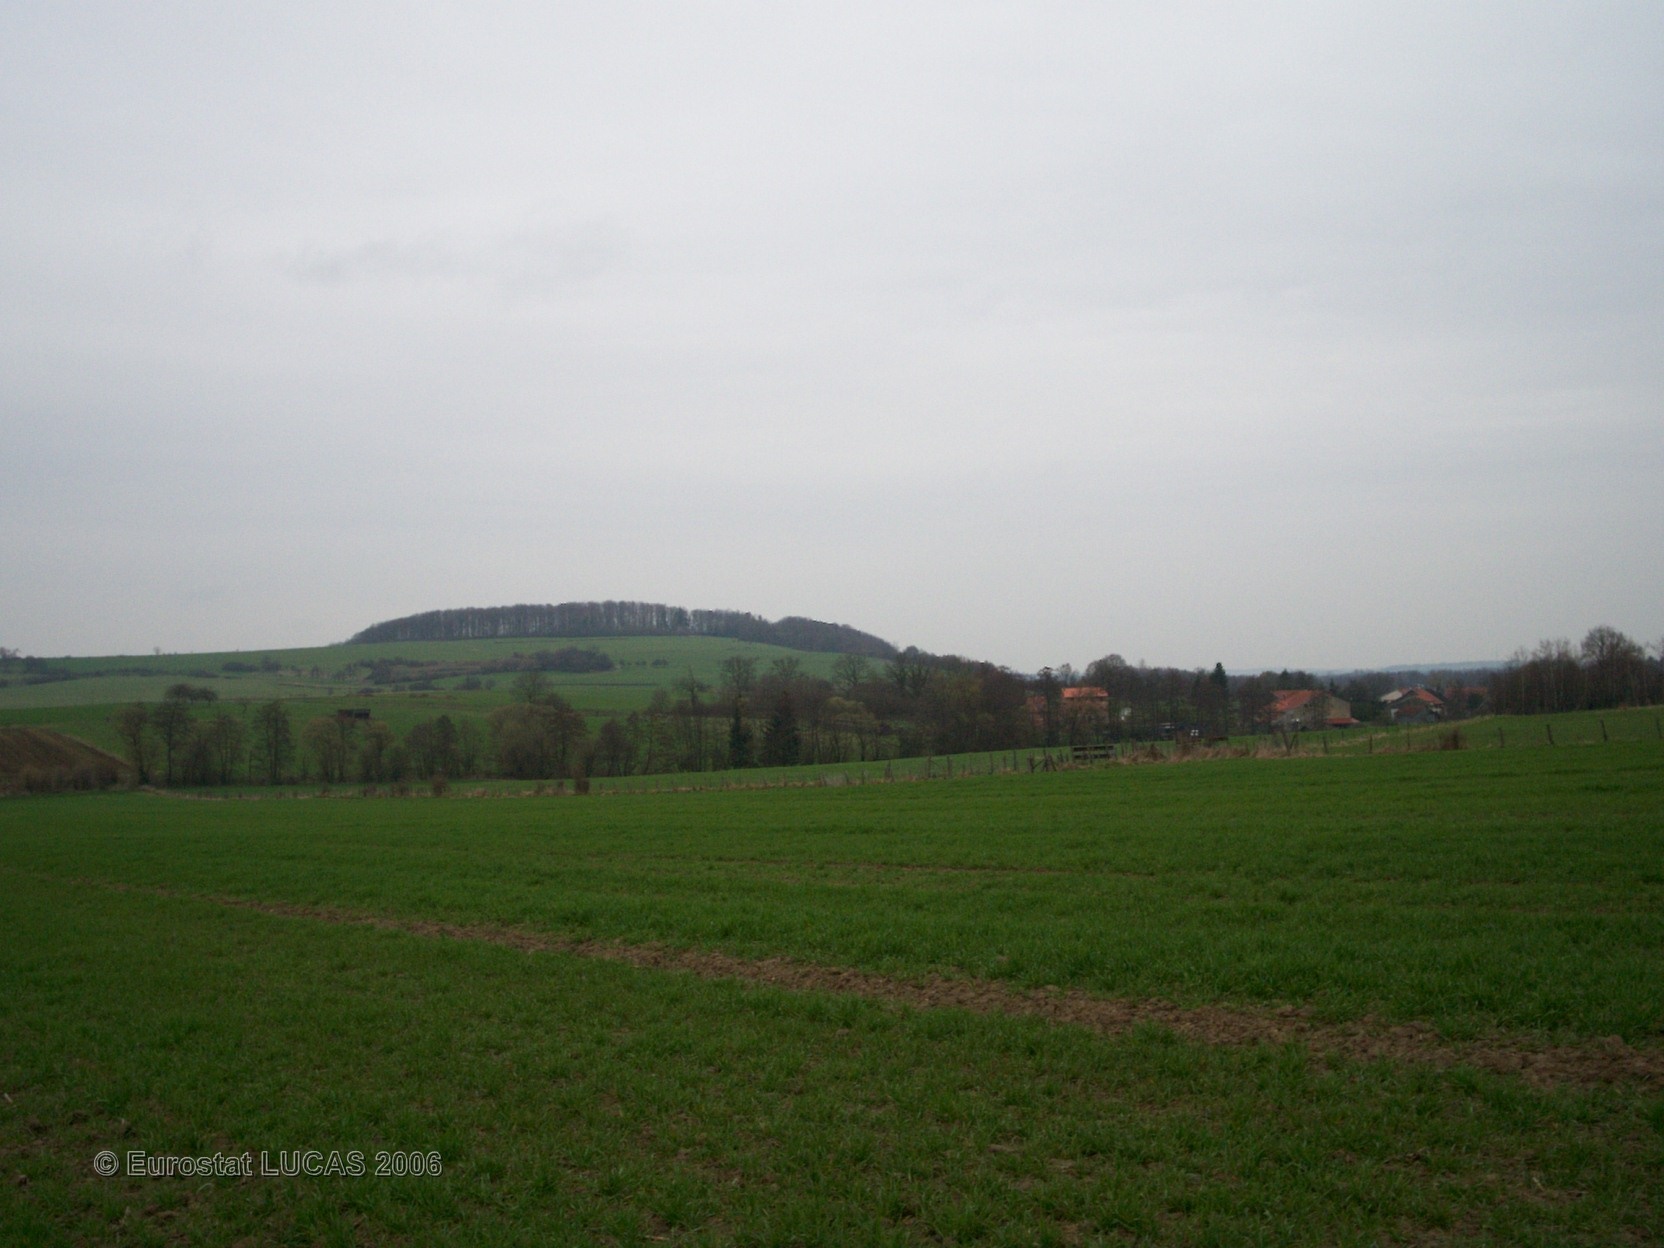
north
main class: Cropland
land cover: Common wheat
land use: Agriculture (excluding fallow land and kitchen gardens)
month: April
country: FR
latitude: 48.6329
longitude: 7.0018
